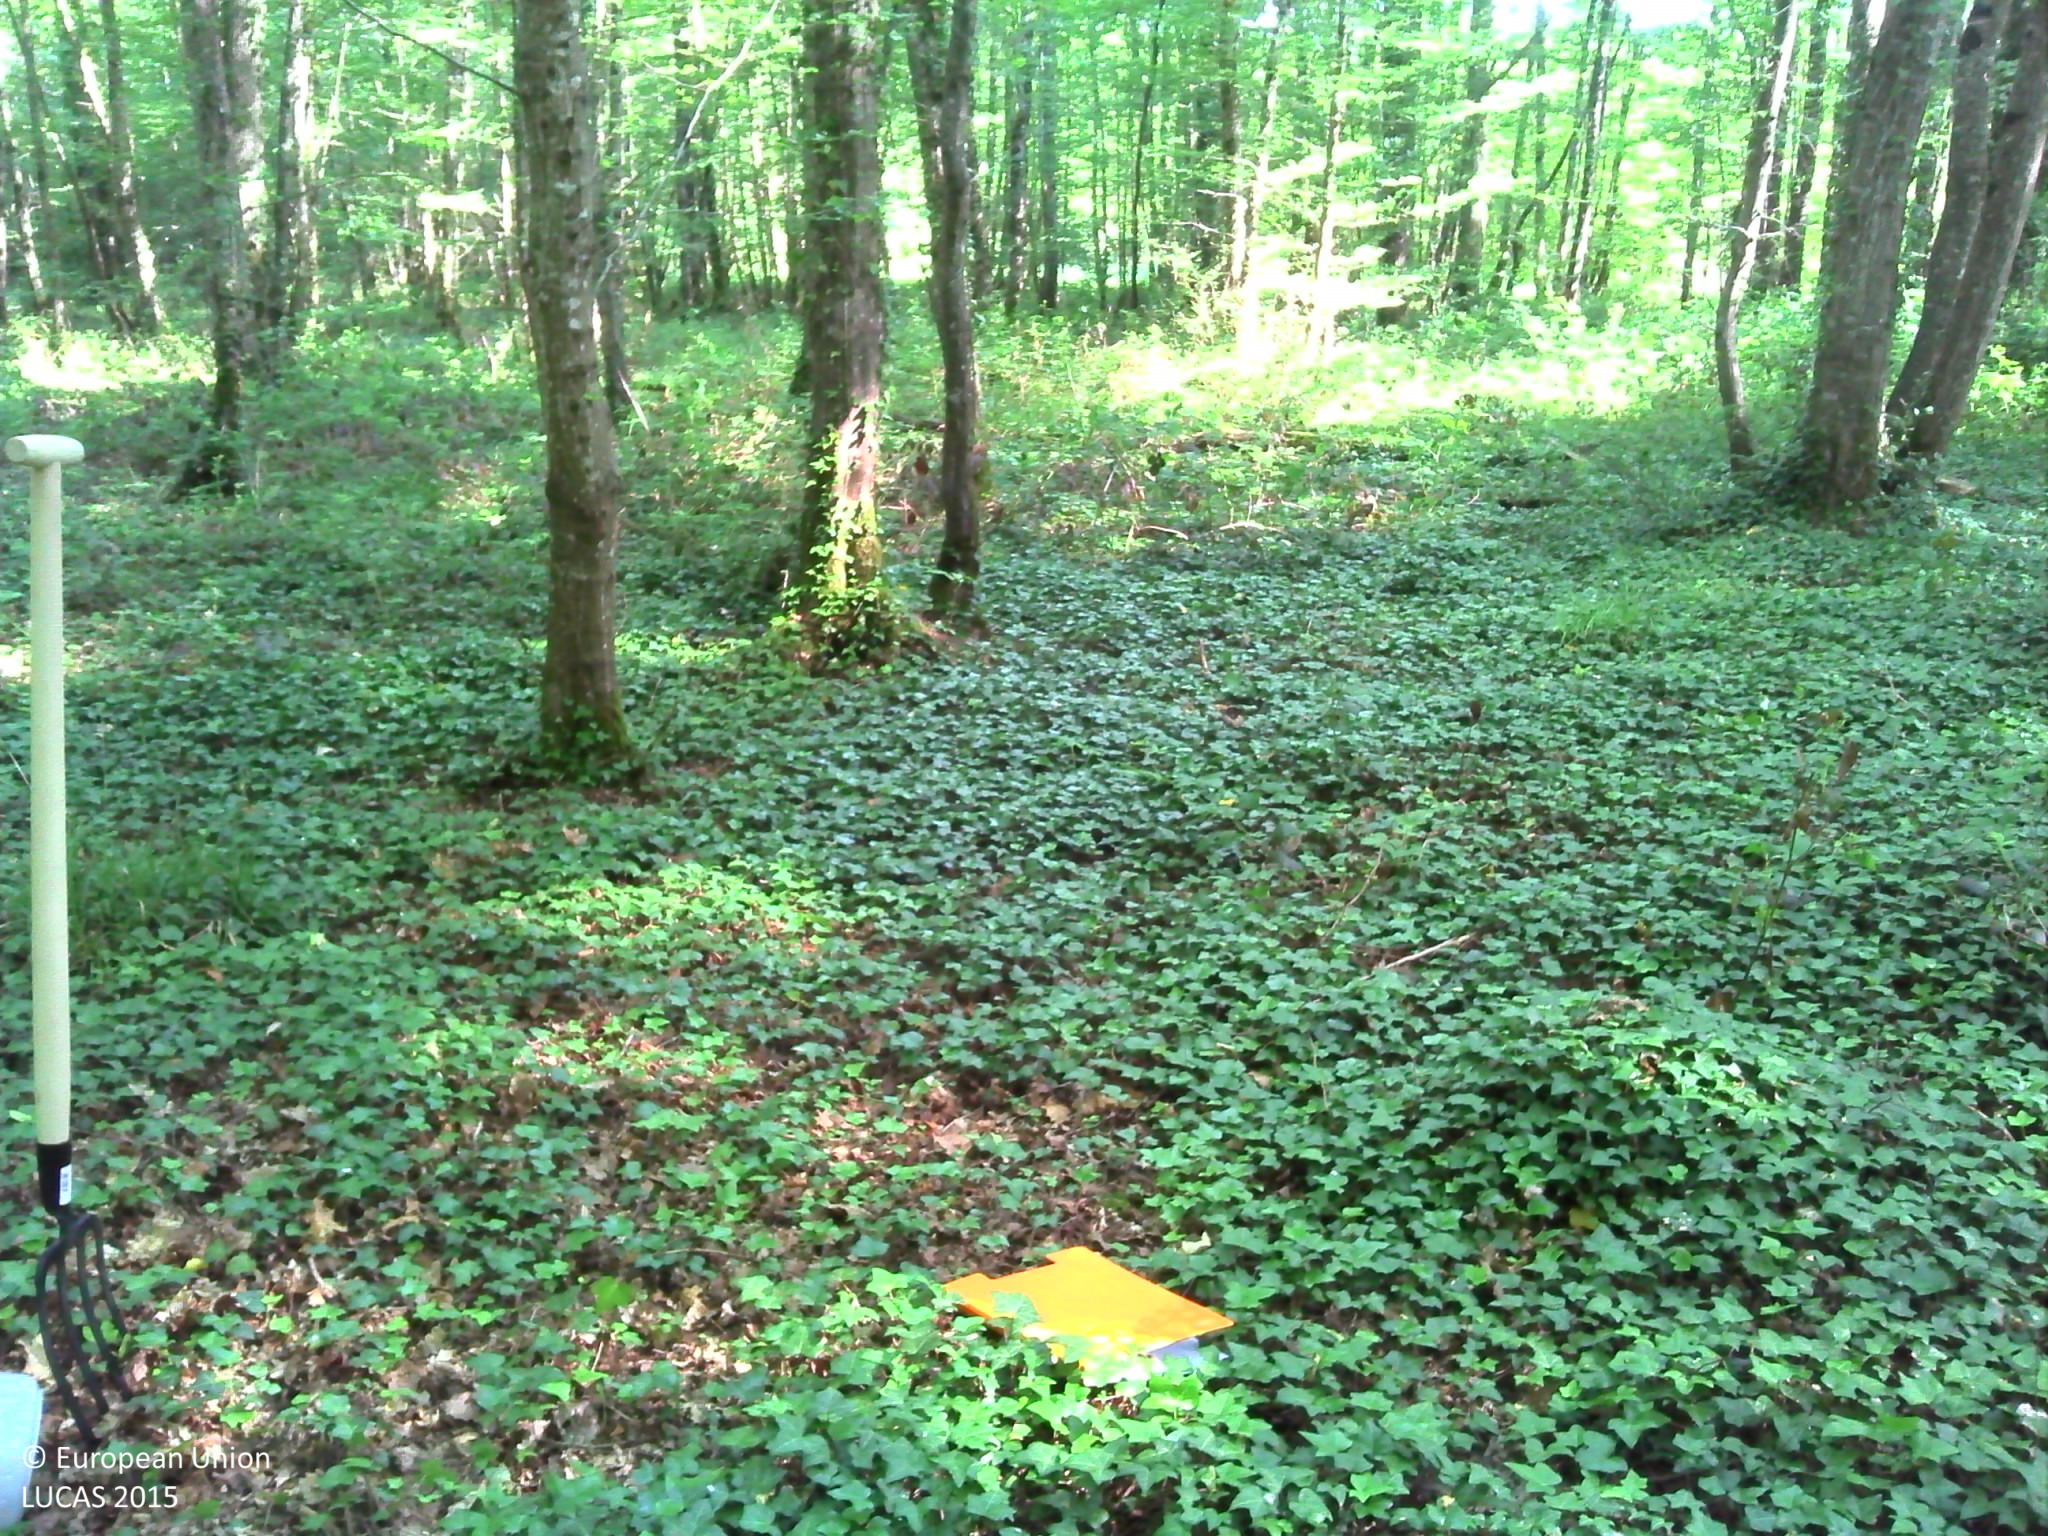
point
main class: Woodland
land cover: Broadleaved woodland
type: mesophytic deciduous forest
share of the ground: > 75 %
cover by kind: broadleaved forest trees 100 %
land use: Forestry
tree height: > 5 m
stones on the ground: < 10 %
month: June
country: FR
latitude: 47.0911
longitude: 2.6298
